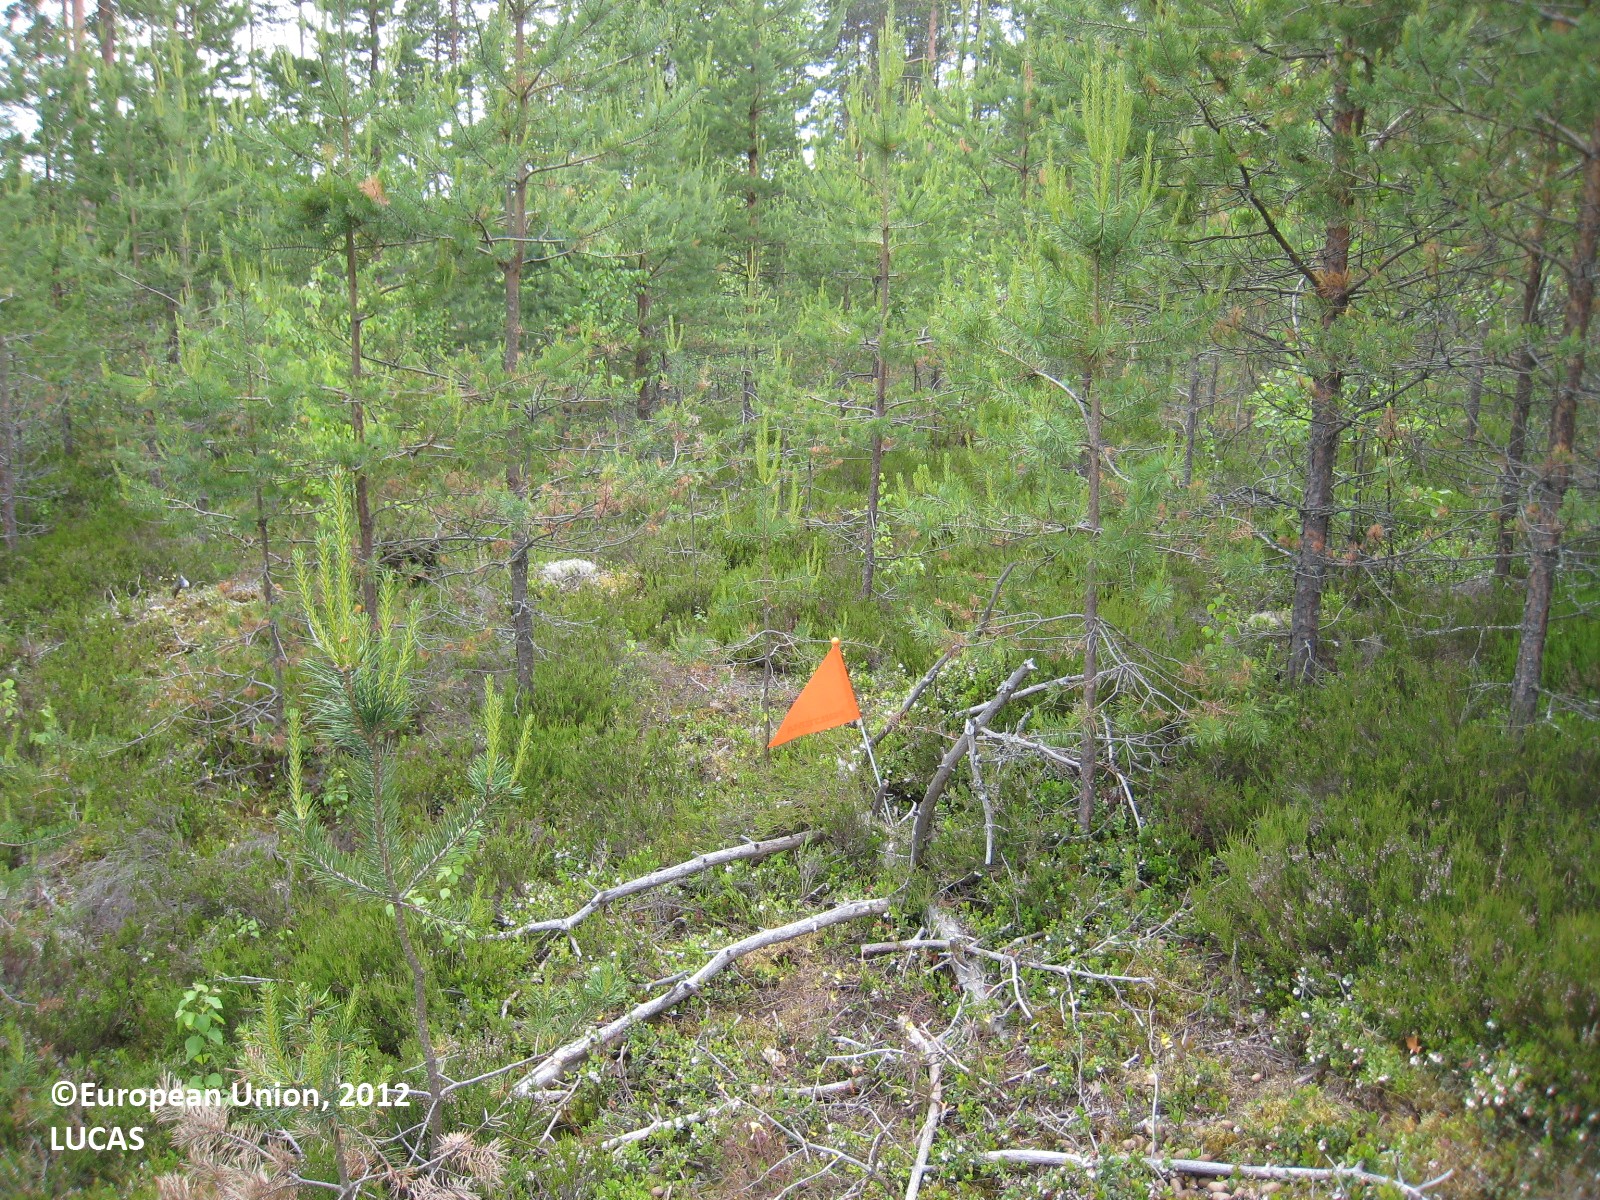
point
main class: Woodland
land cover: Pine dominated coniferous woodland
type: boreal forest
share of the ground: 50 - 75 %
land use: Forestry
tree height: < 5 m
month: June
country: FI
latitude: 61.9863
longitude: 26.1848
